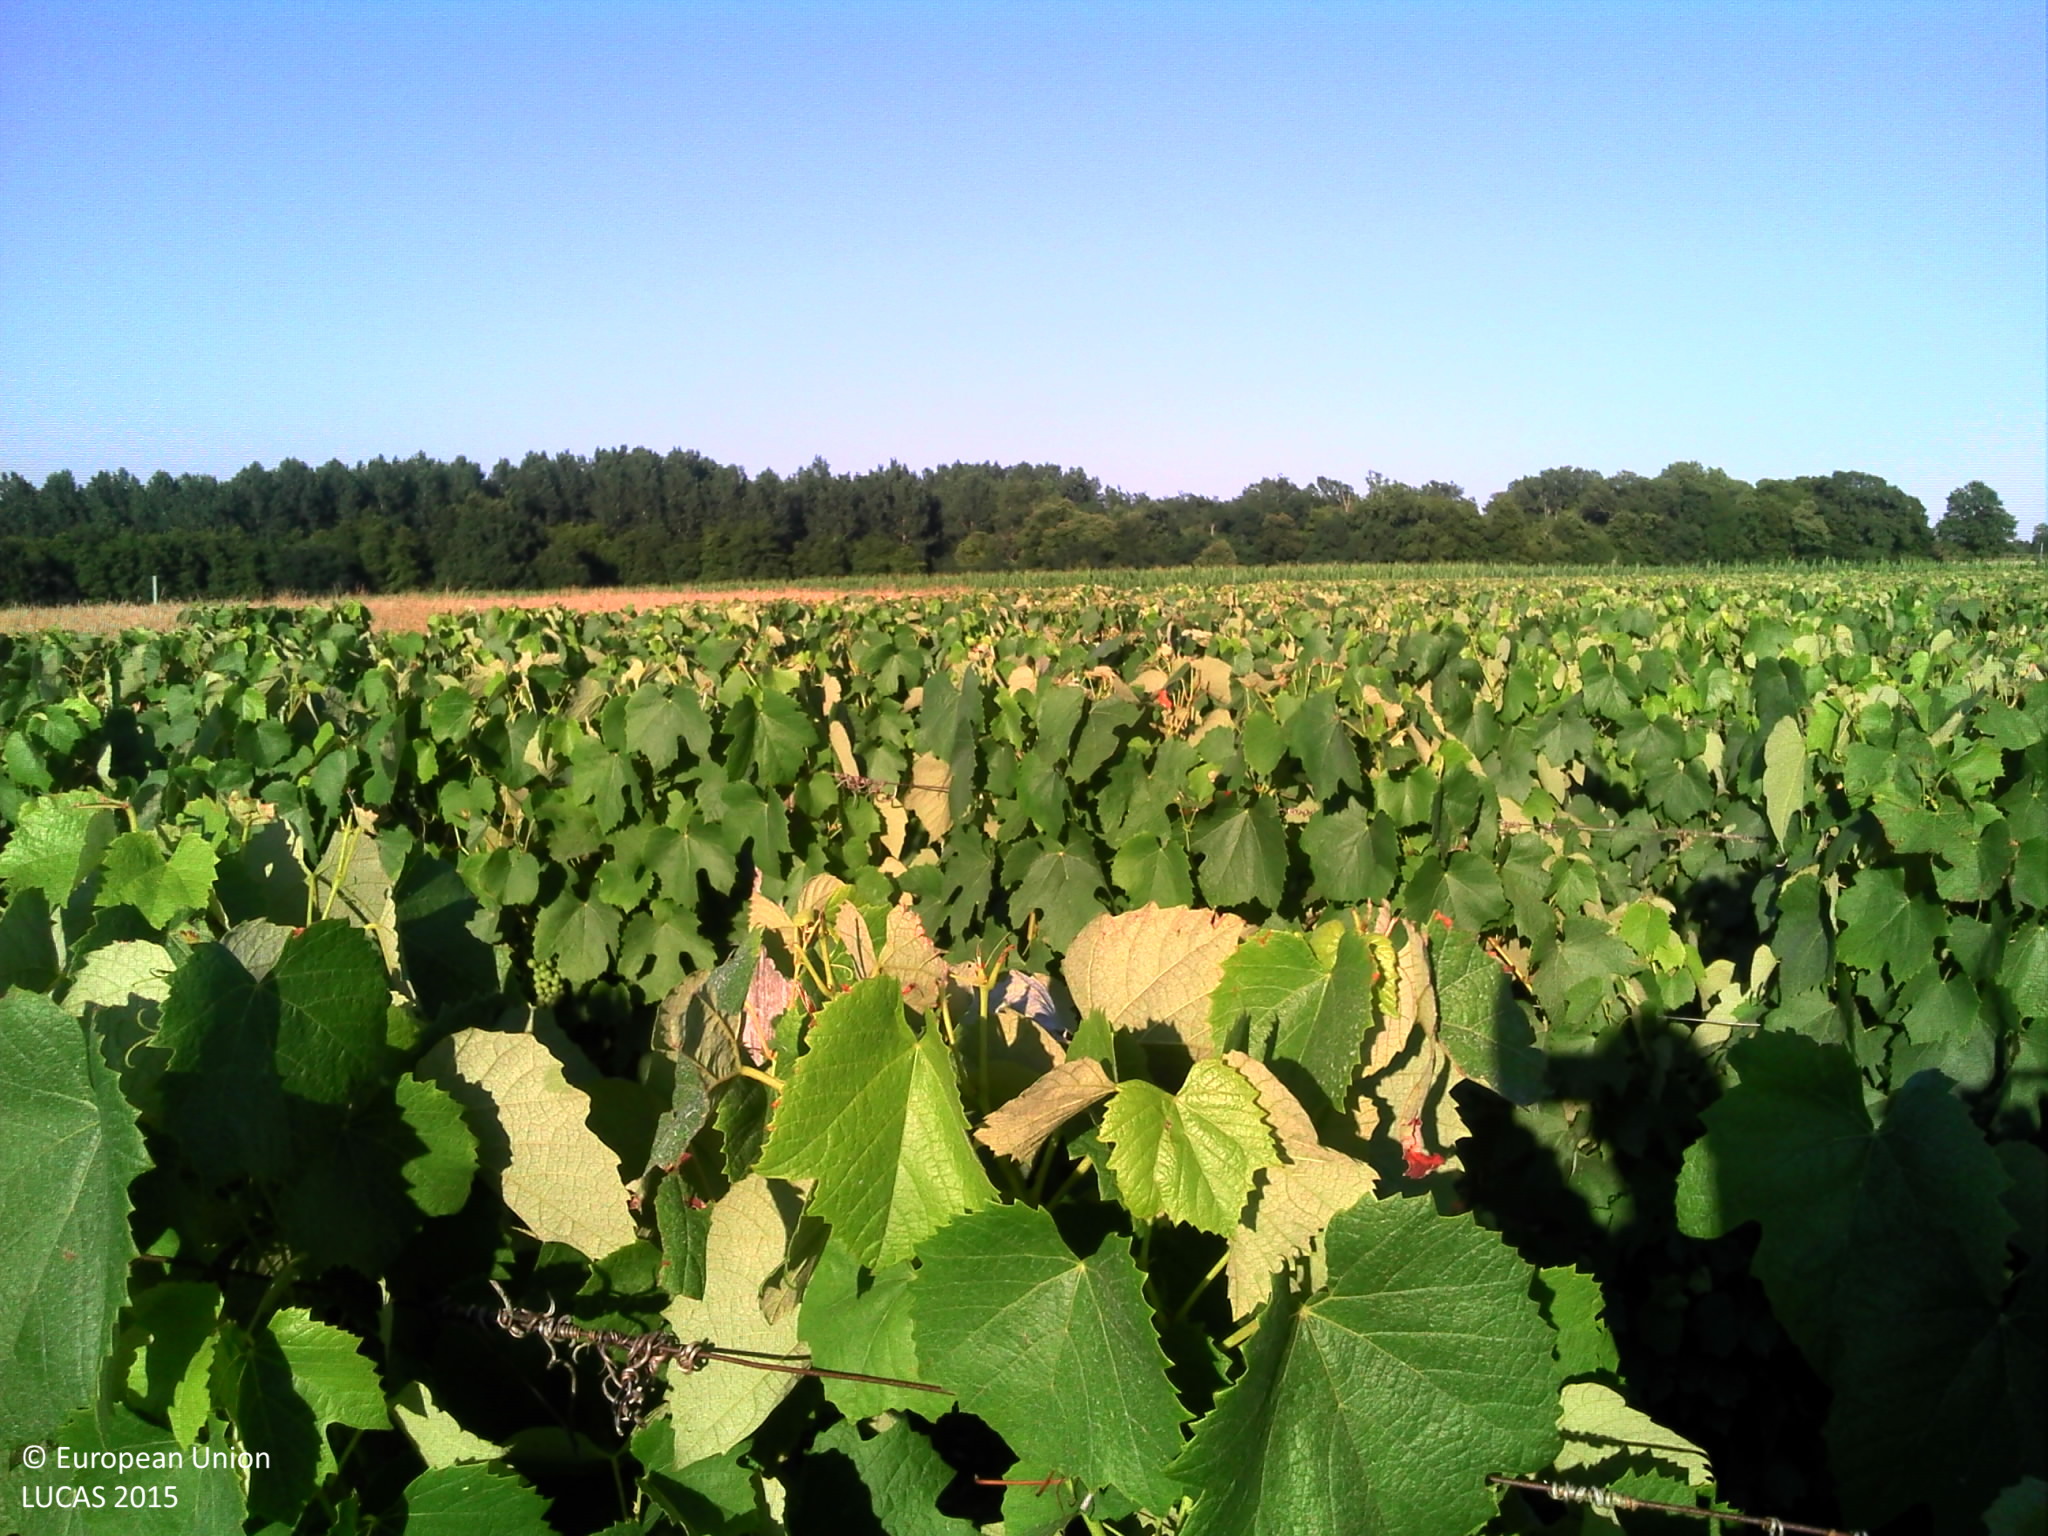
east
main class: Cropland
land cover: Vineyards
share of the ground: 25 - 50 %
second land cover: Grassland without tree/shrub cover
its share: 25 - 50 %
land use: Agriculture (excluding fallow land and kitchen gardens)
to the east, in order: Vineyards; Grassland without tree/shrub cover; Maize
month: July
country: FR
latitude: 43.8957
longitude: -0.2555
